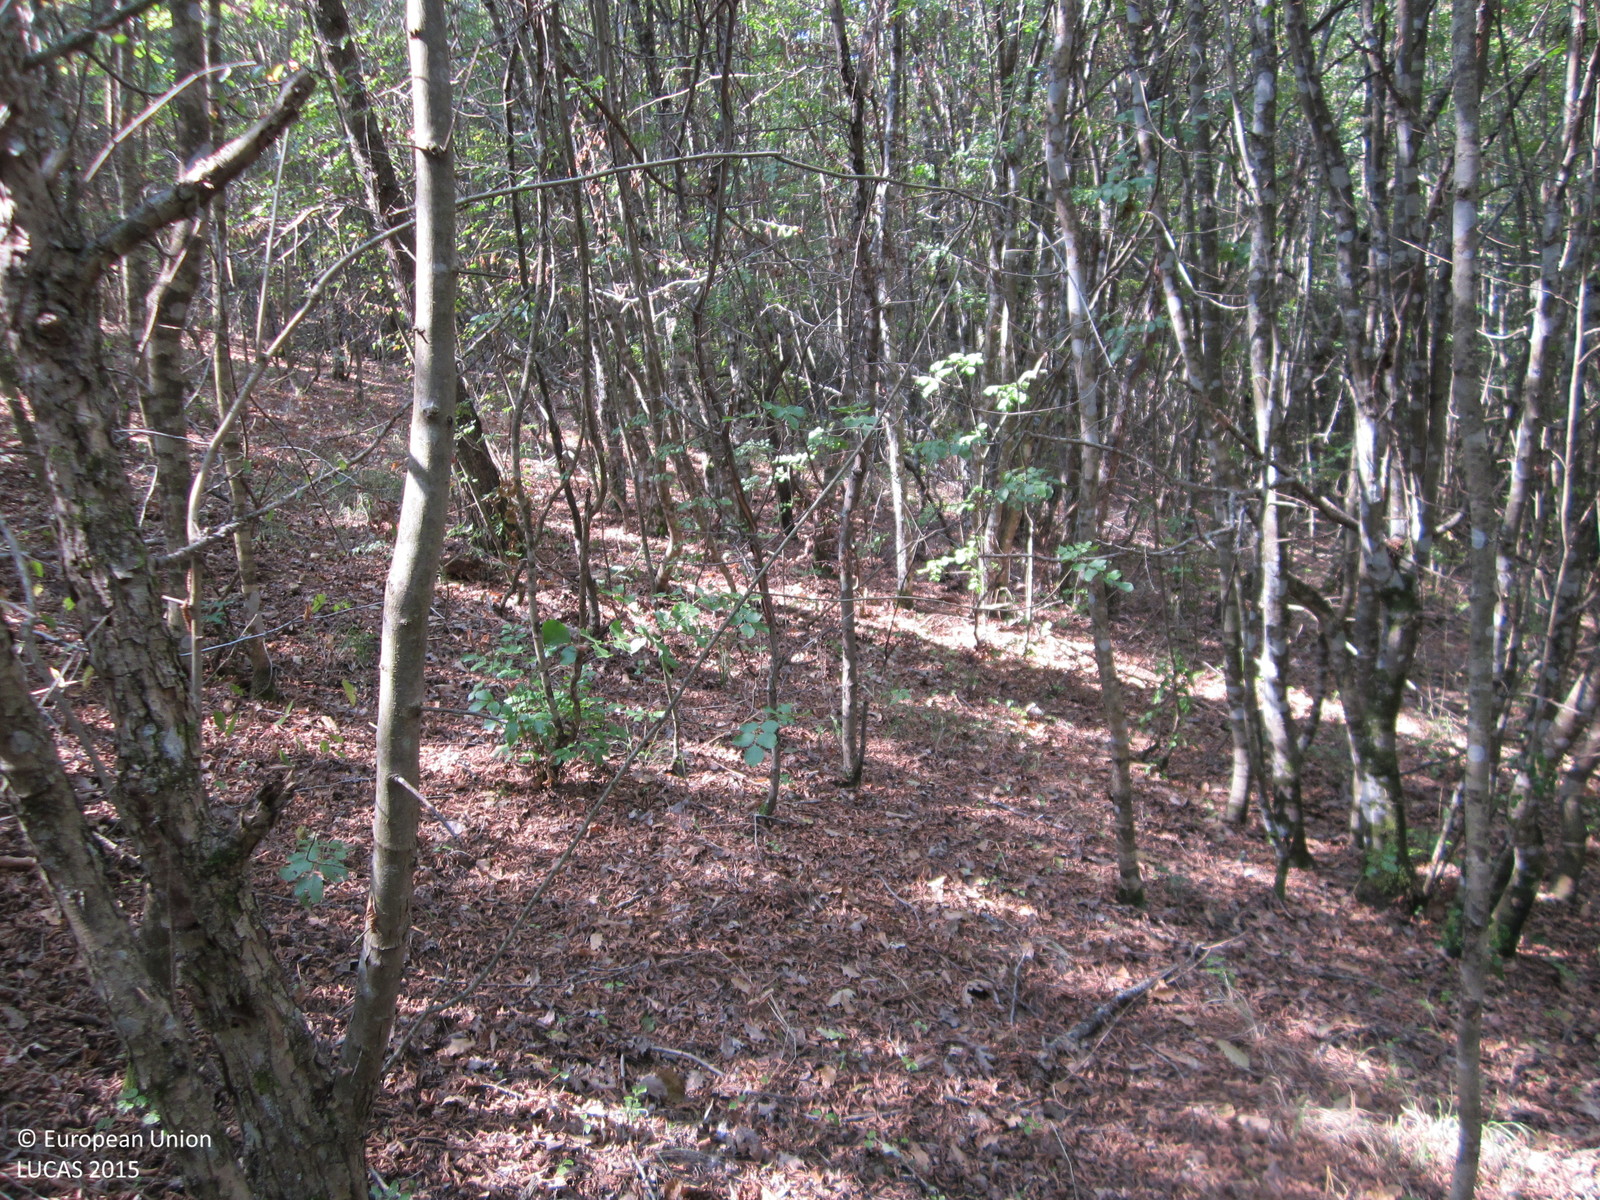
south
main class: Woodland
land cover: Broadleaved woodland
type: thermophilous deciduous forest
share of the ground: > 75 %
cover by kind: broadleaved forest trees 95 %, unconsolidated bare surface 5 %
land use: Forestry
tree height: > 5 m
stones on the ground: < 10 %
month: August
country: BG
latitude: 42.0358
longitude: 27.6177
